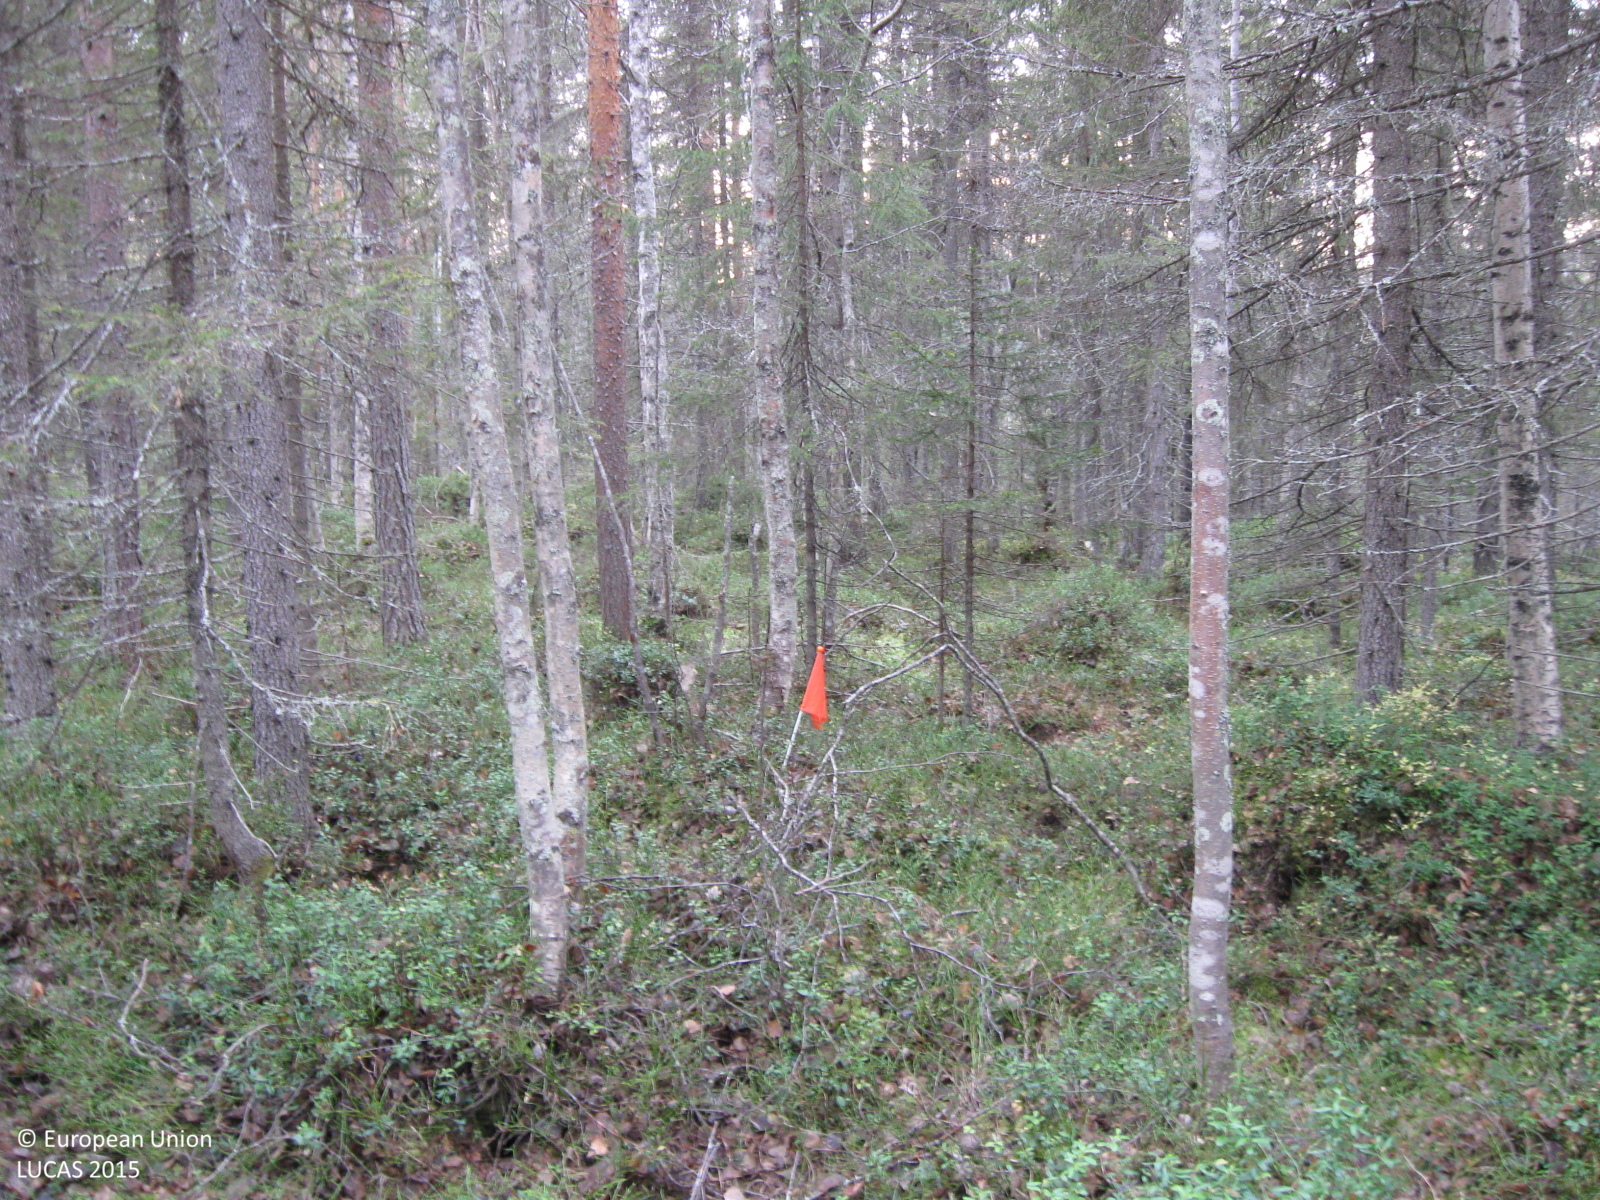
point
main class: Woodland
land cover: Other mixed woodland
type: boreal forest
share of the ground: > 75 %
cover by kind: coniferous forest trees 60 %, broadleaved forest trees 20 %, shrubs 10 %, herbaceous plants 5 %, lichens and mosses 5 %
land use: Forestry
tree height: > 5 m
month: October
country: SE
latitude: 66.1740
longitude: 21.5248
